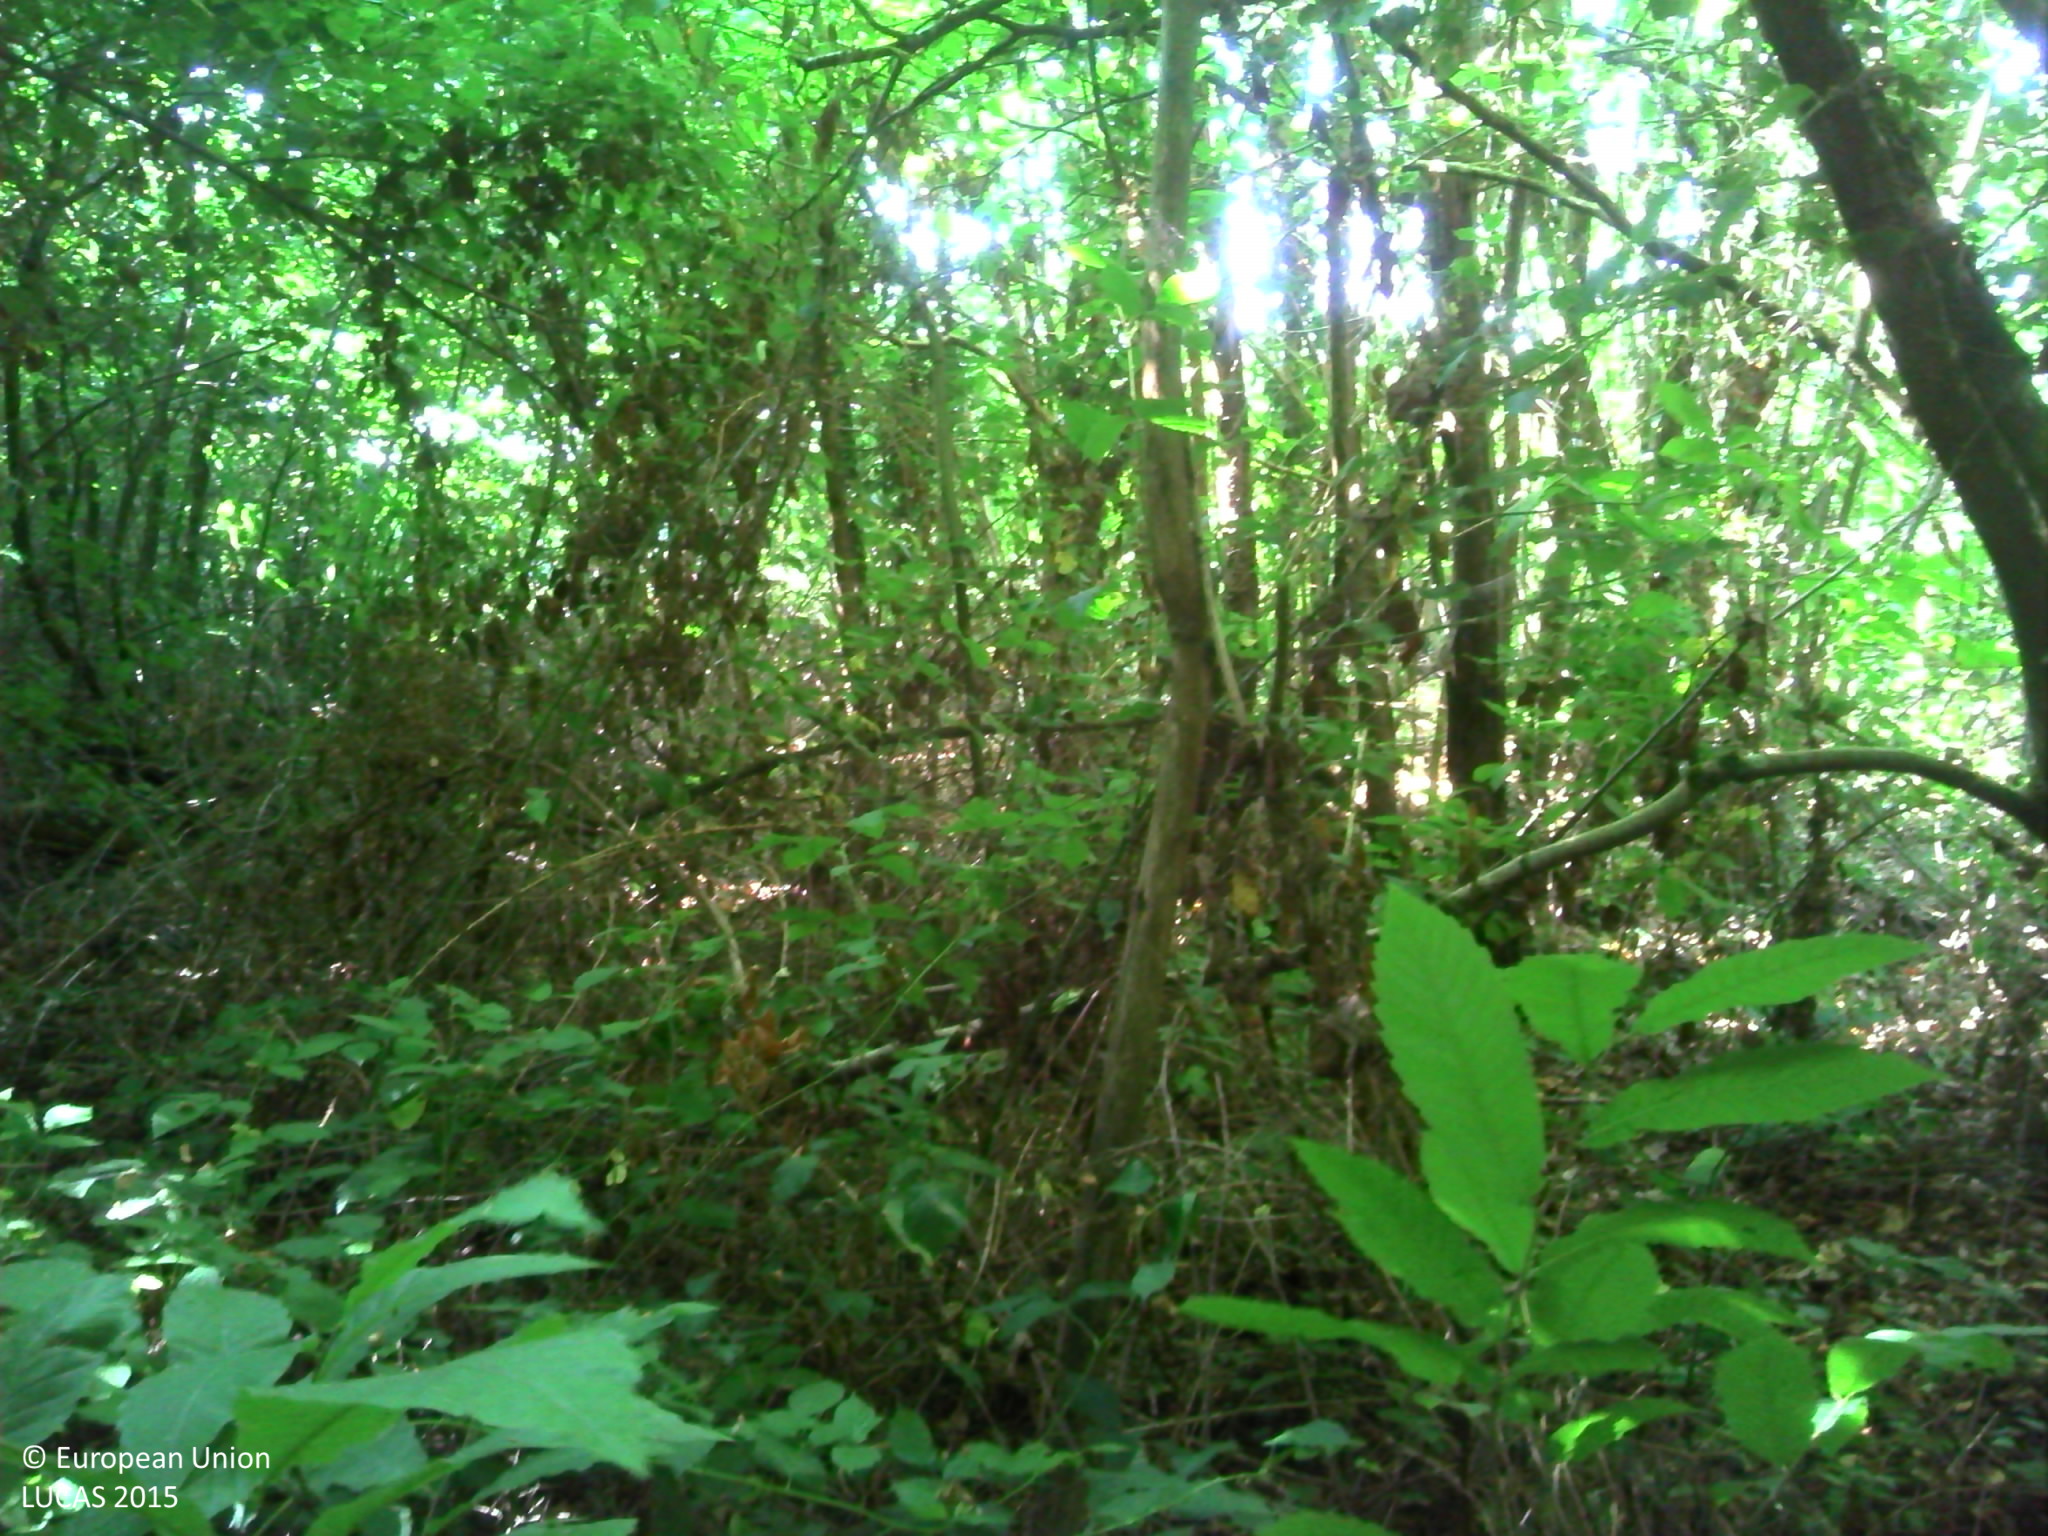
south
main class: Woodland
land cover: Broadleaved woodland
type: non-riverine alder, birch or aspen forest
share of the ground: > 75 %
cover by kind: broadleaved forest trees 95 %, herbaceous plants 5 %
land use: Semi-natural and natural areas not in use
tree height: > 5 m
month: July
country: FR
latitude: 47.6772
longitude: -1.8093
